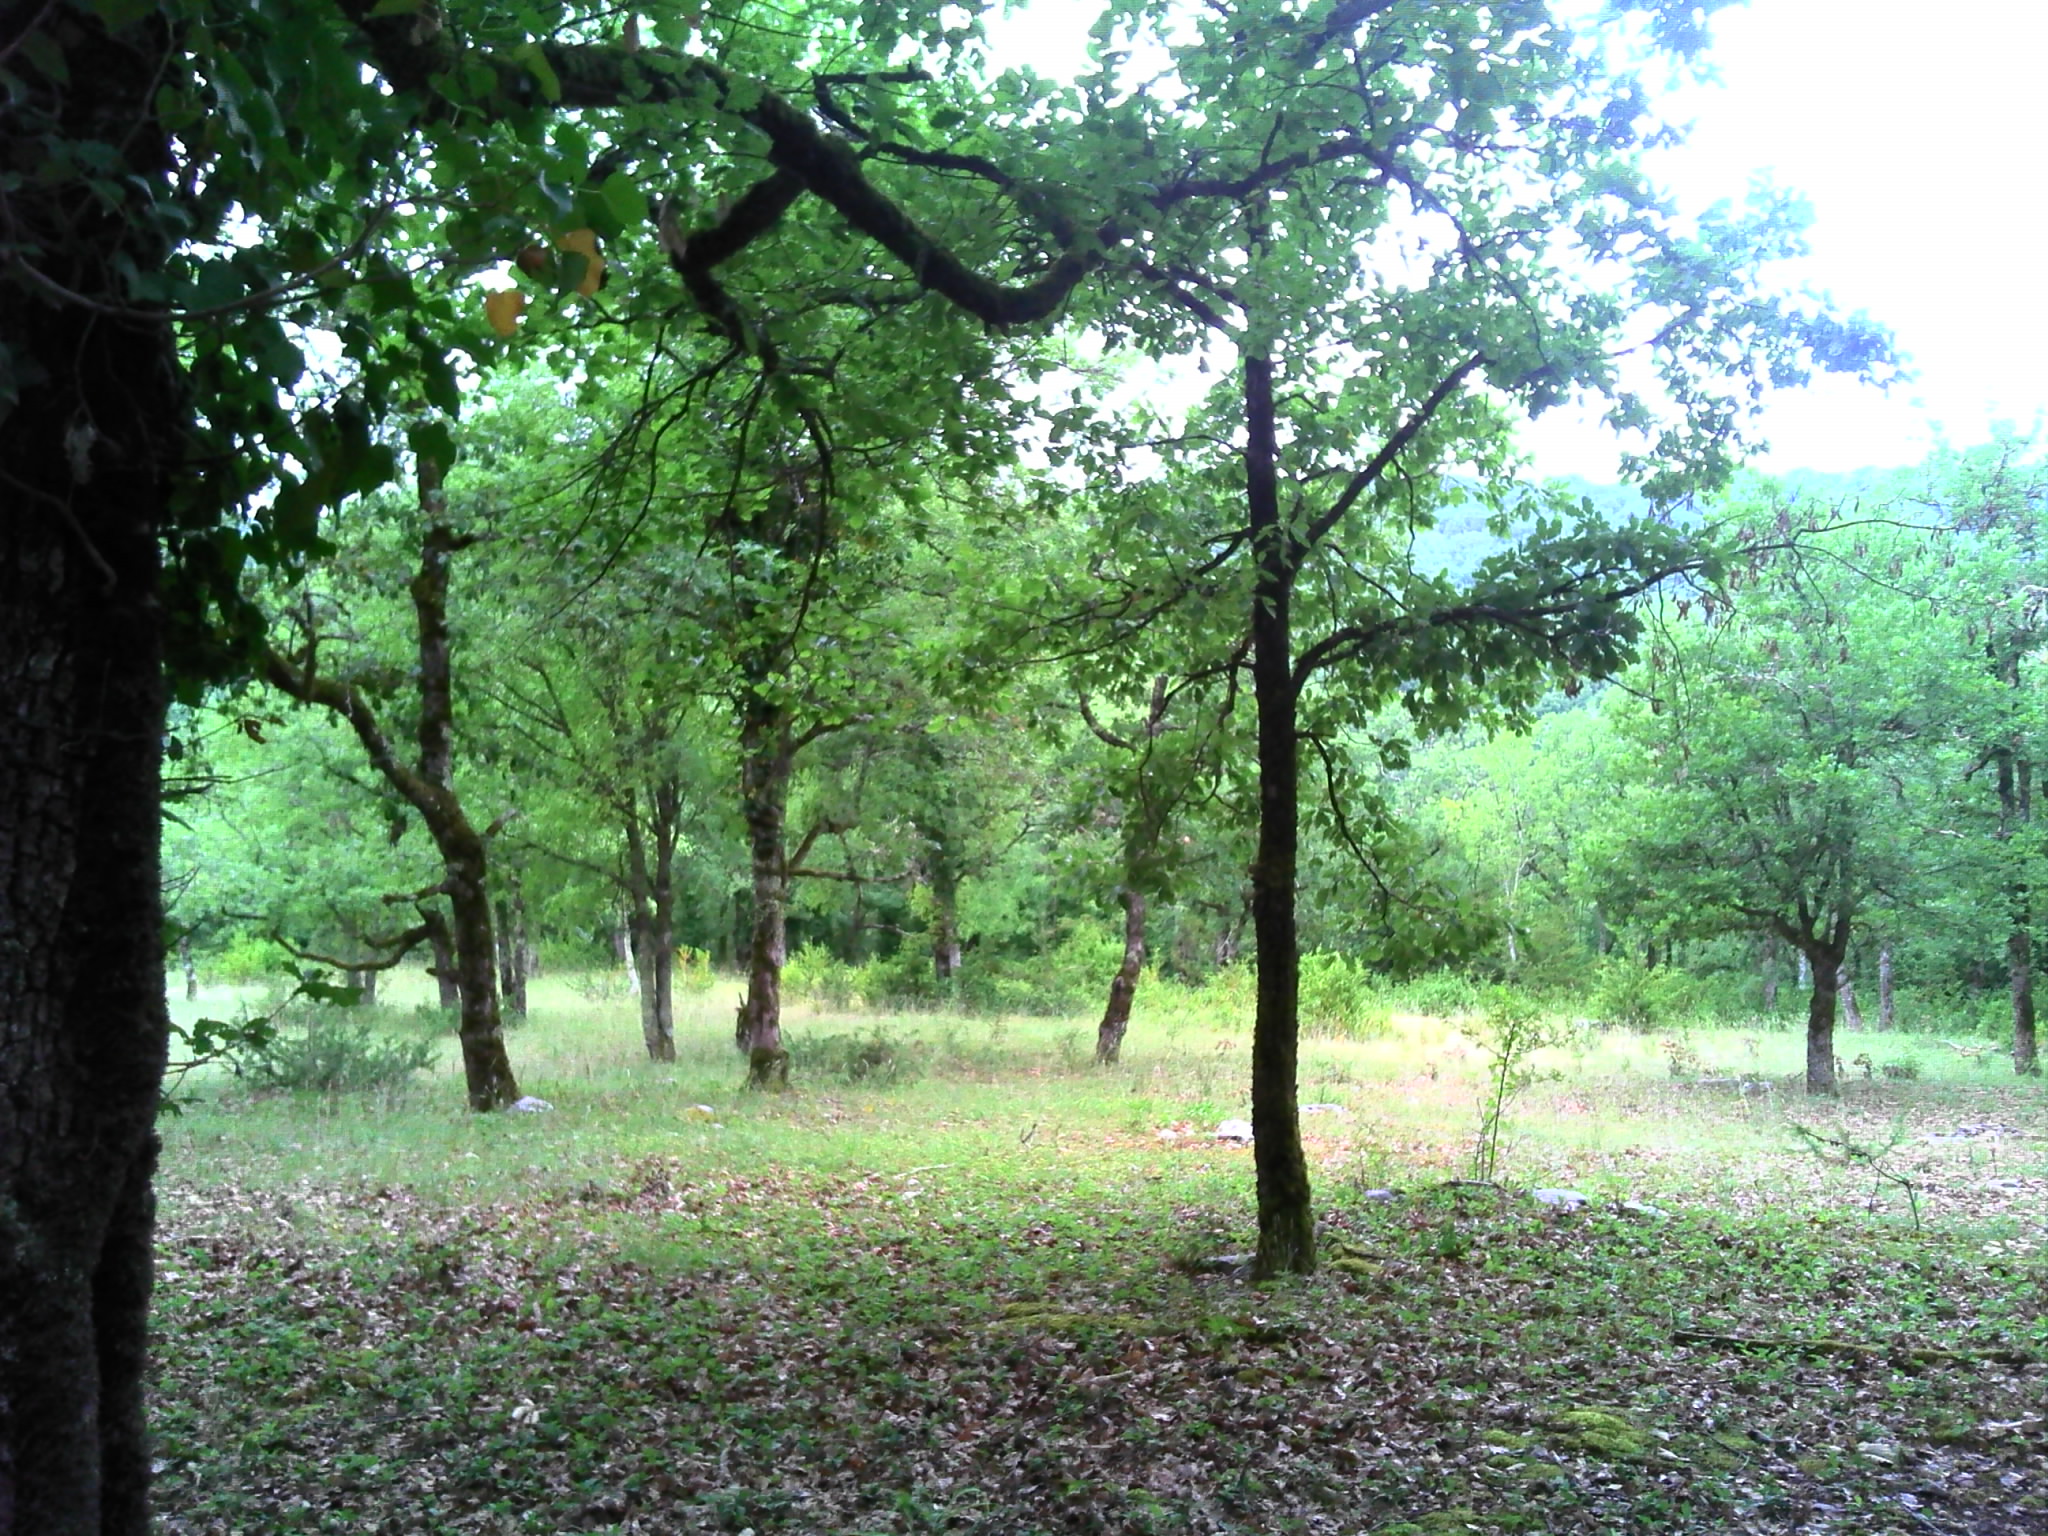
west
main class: Woodland
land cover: Broadleaved woodland
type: acidophilous oak and oak-birch forest
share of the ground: > 75 %
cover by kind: broadleaved forest trees 90 %, herbaceous plants 10 %
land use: Forestry
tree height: > 5 m
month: June
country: FR
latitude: 44.4440
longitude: 1.8202
